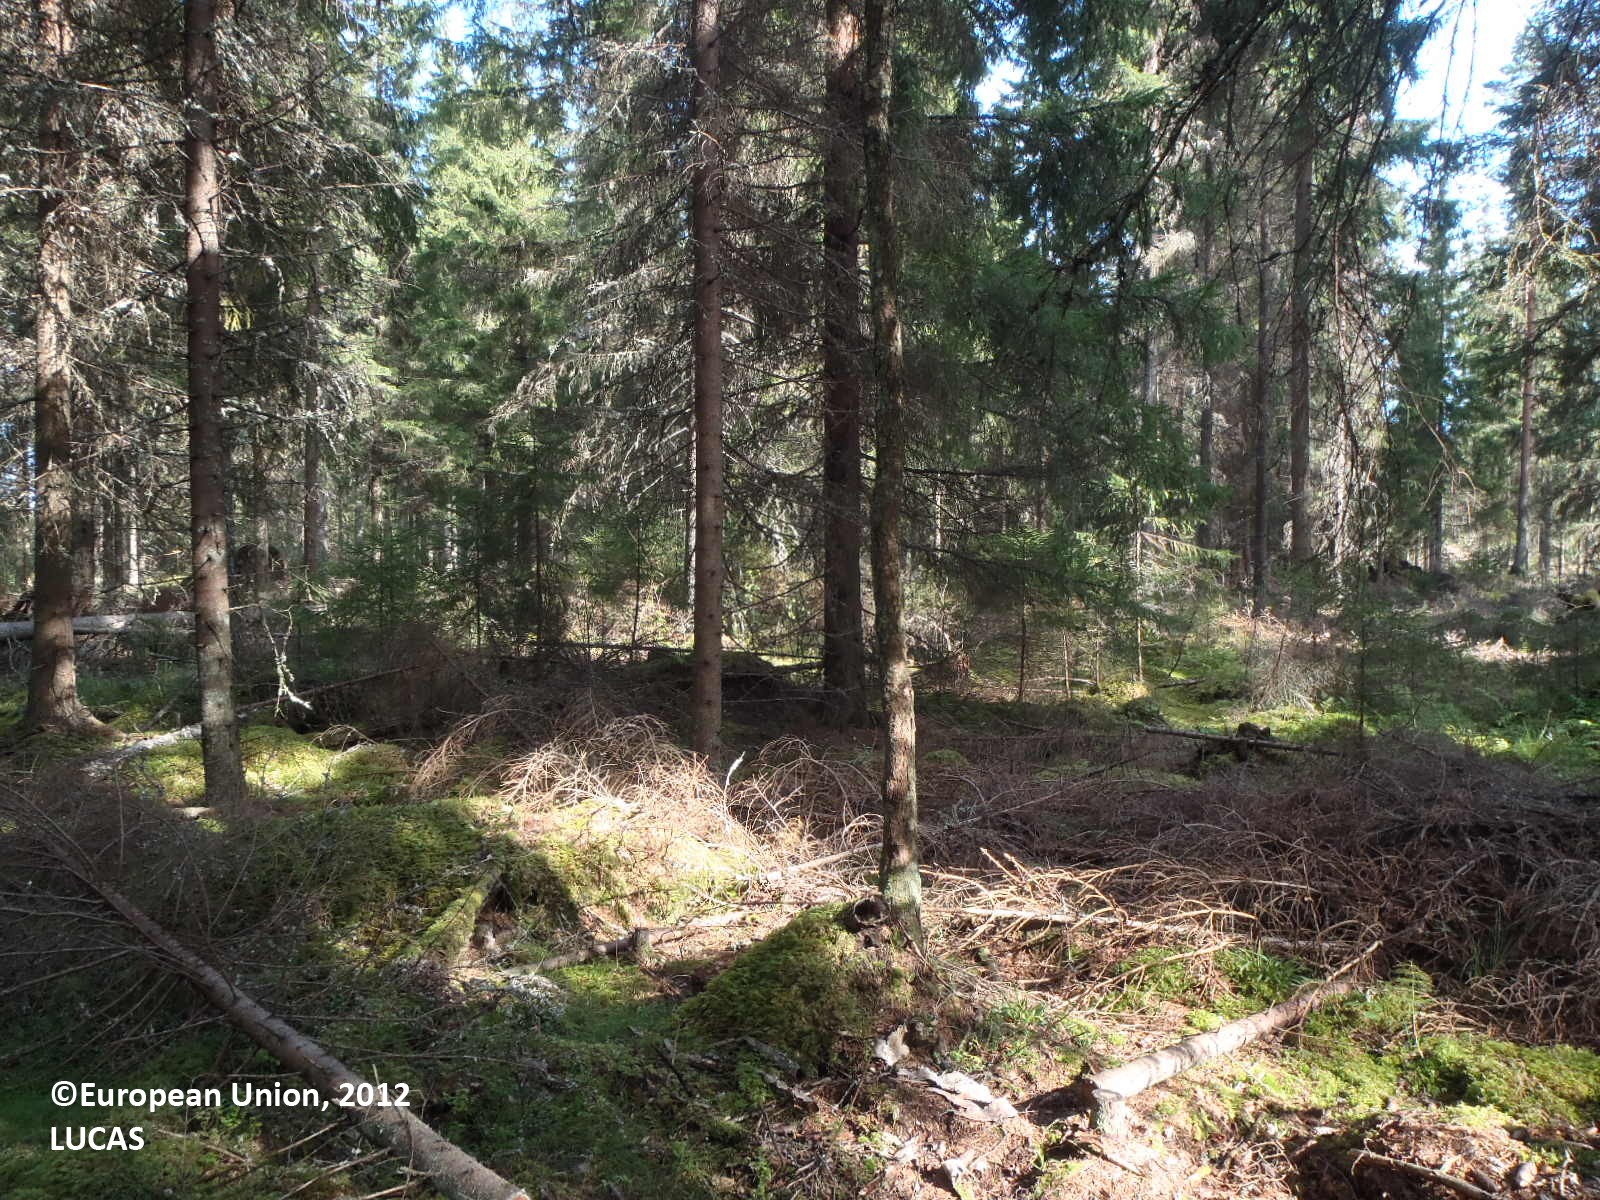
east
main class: Woodland
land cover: Spruce dominated coniferous woodland
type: boreal forest
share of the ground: > 75 %
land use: Forestry
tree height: > 5 m
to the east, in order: Spruce dominated coniferous woodland; Ditches and canals; Spruce dominated coniferous woodland; Ditches and canals; Spruce dominated coniferous woodland; Ditches and canals; Spruce dominated coniferous woodland; Grass margins; Tracks; Grass margins; Paved roads, cycling and walking lanes; Grass margins; Ditches and canals; Spruce dominated mixed woodland
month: September
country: FI
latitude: 61.1276
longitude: 22.4107
